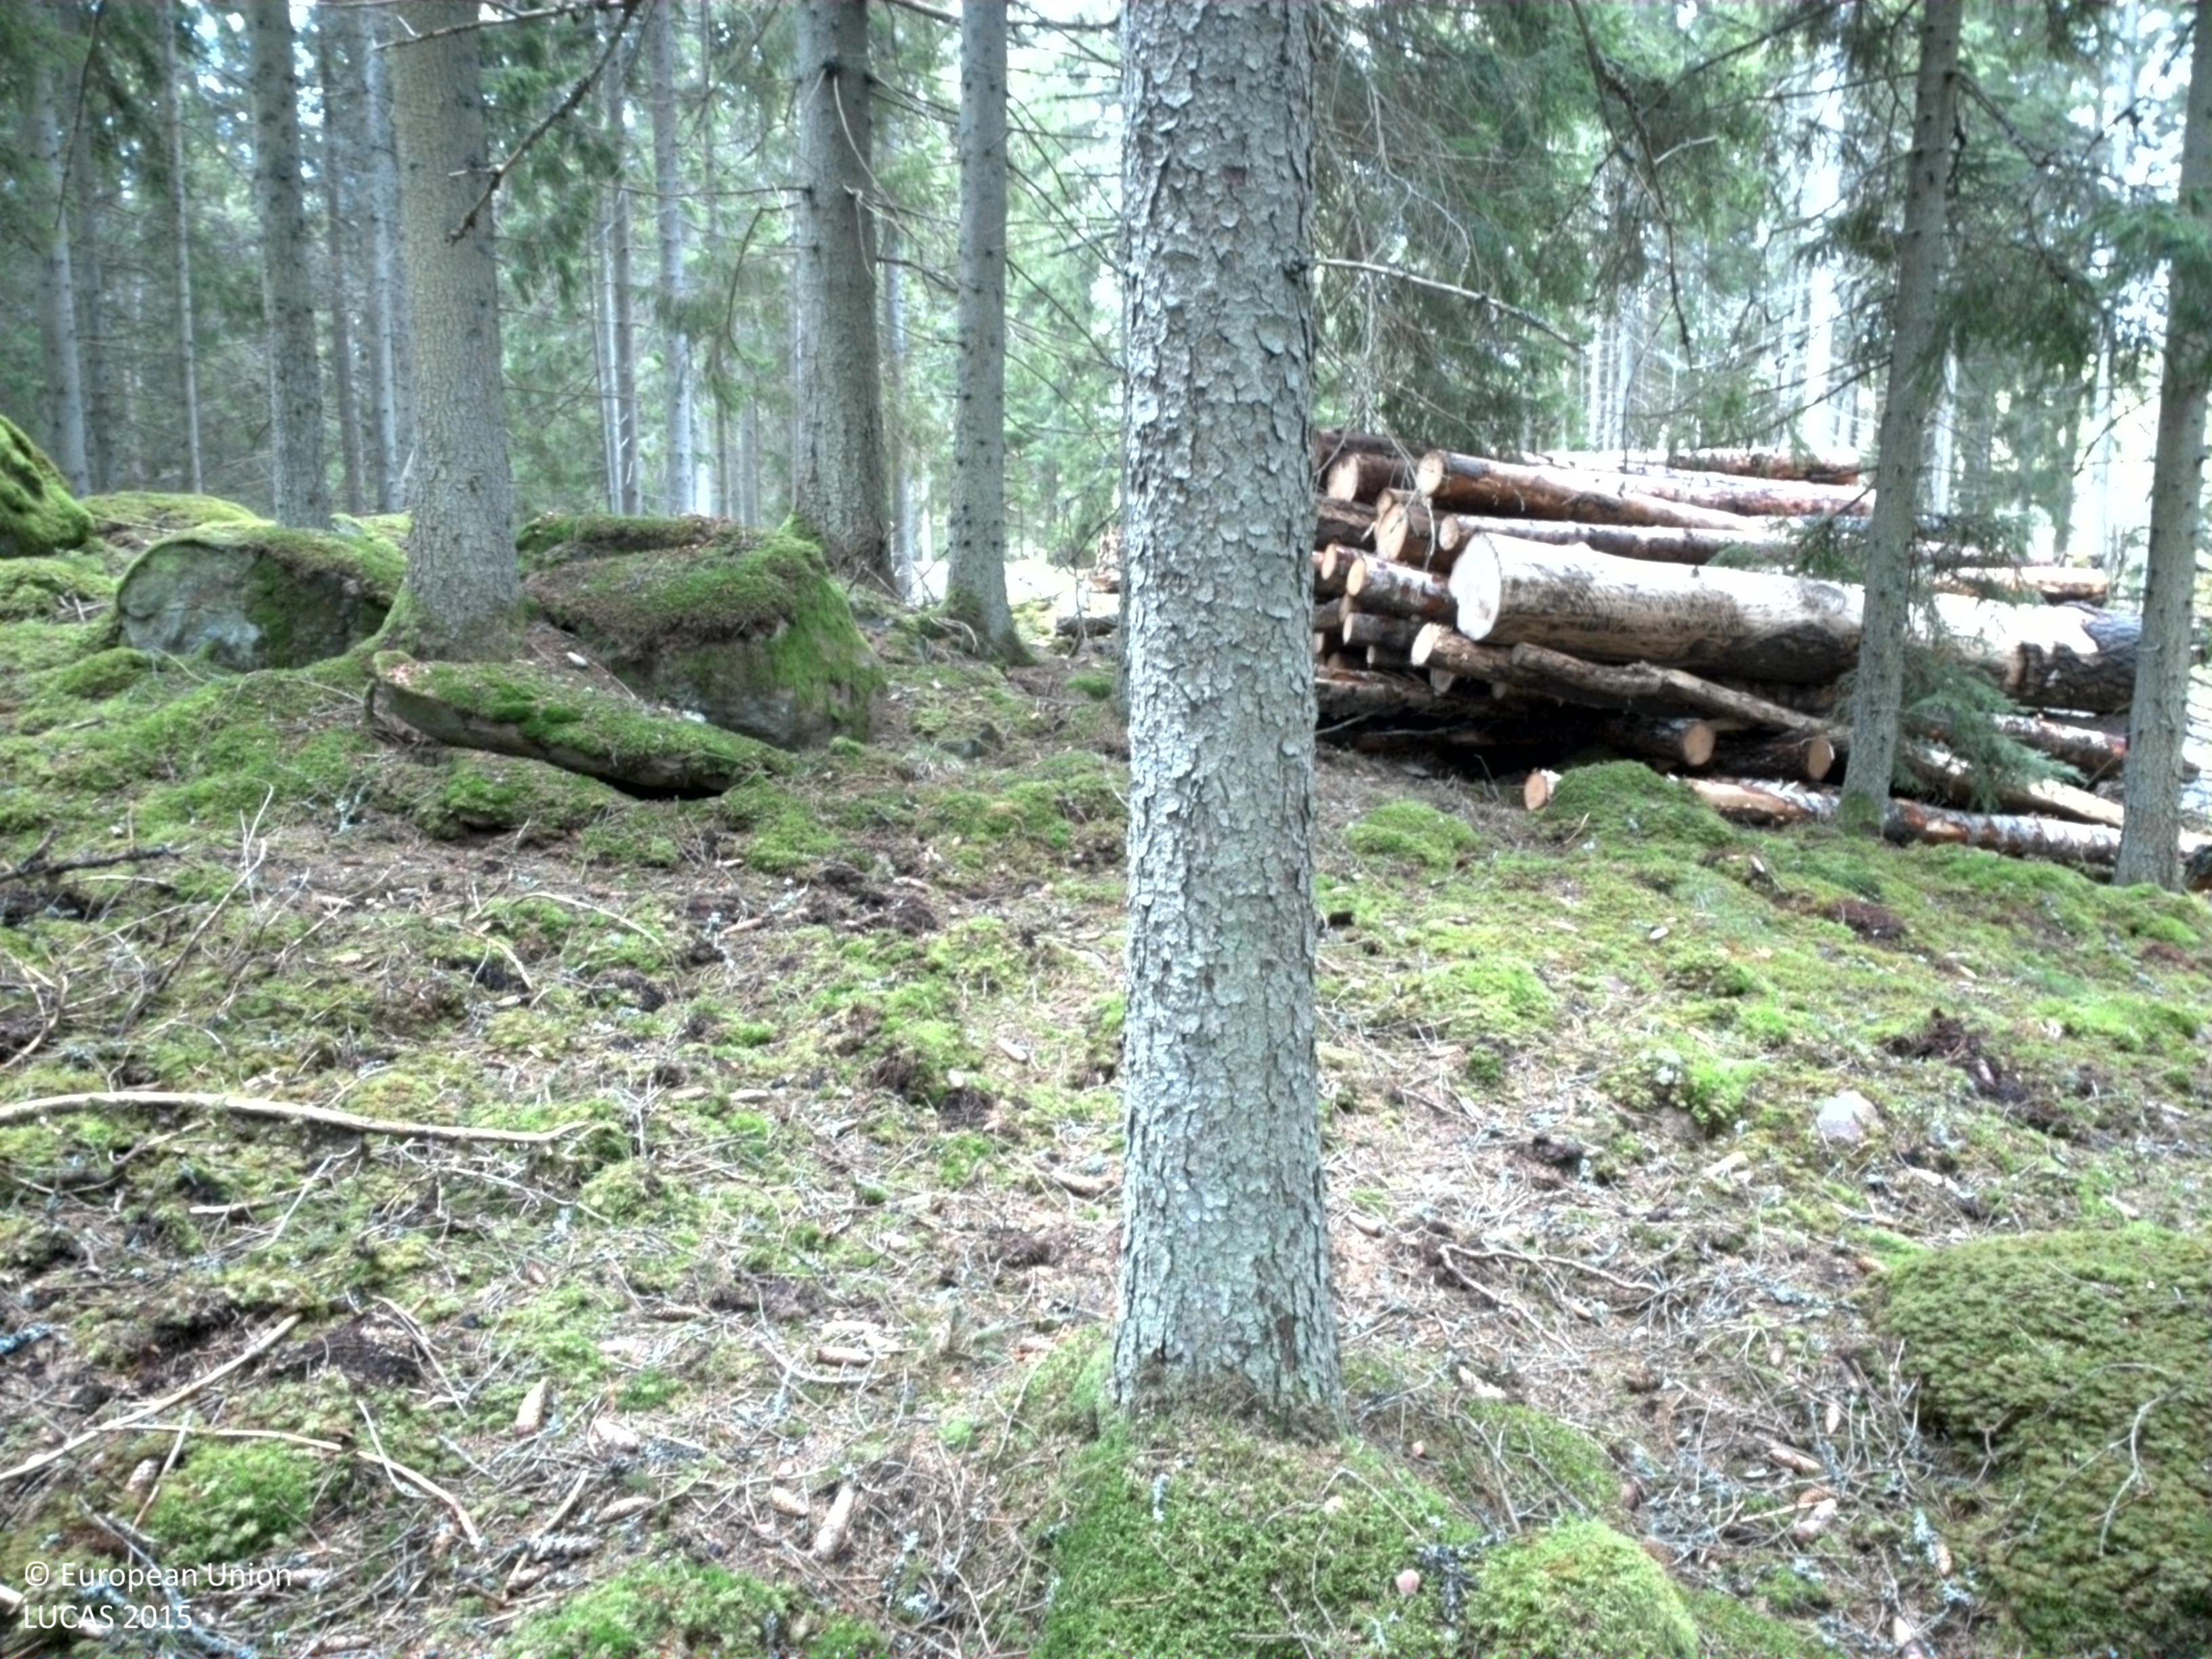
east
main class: Woodland
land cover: Spruce dominated coniferous woodland
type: boreal forest
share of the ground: > 75 %
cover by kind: coniferous forest trees 95 %, lichens and mosses 5 %
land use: Forestry
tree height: > 5 m
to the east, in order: Spruce dominated coniferous woodland; Paved roads, cycling and walking lanes; Spruce dominated coniferous woodland; Rivers and streams; Broadleaved woodland
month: May
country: SE
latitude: 56.5036
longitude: 15.4741
